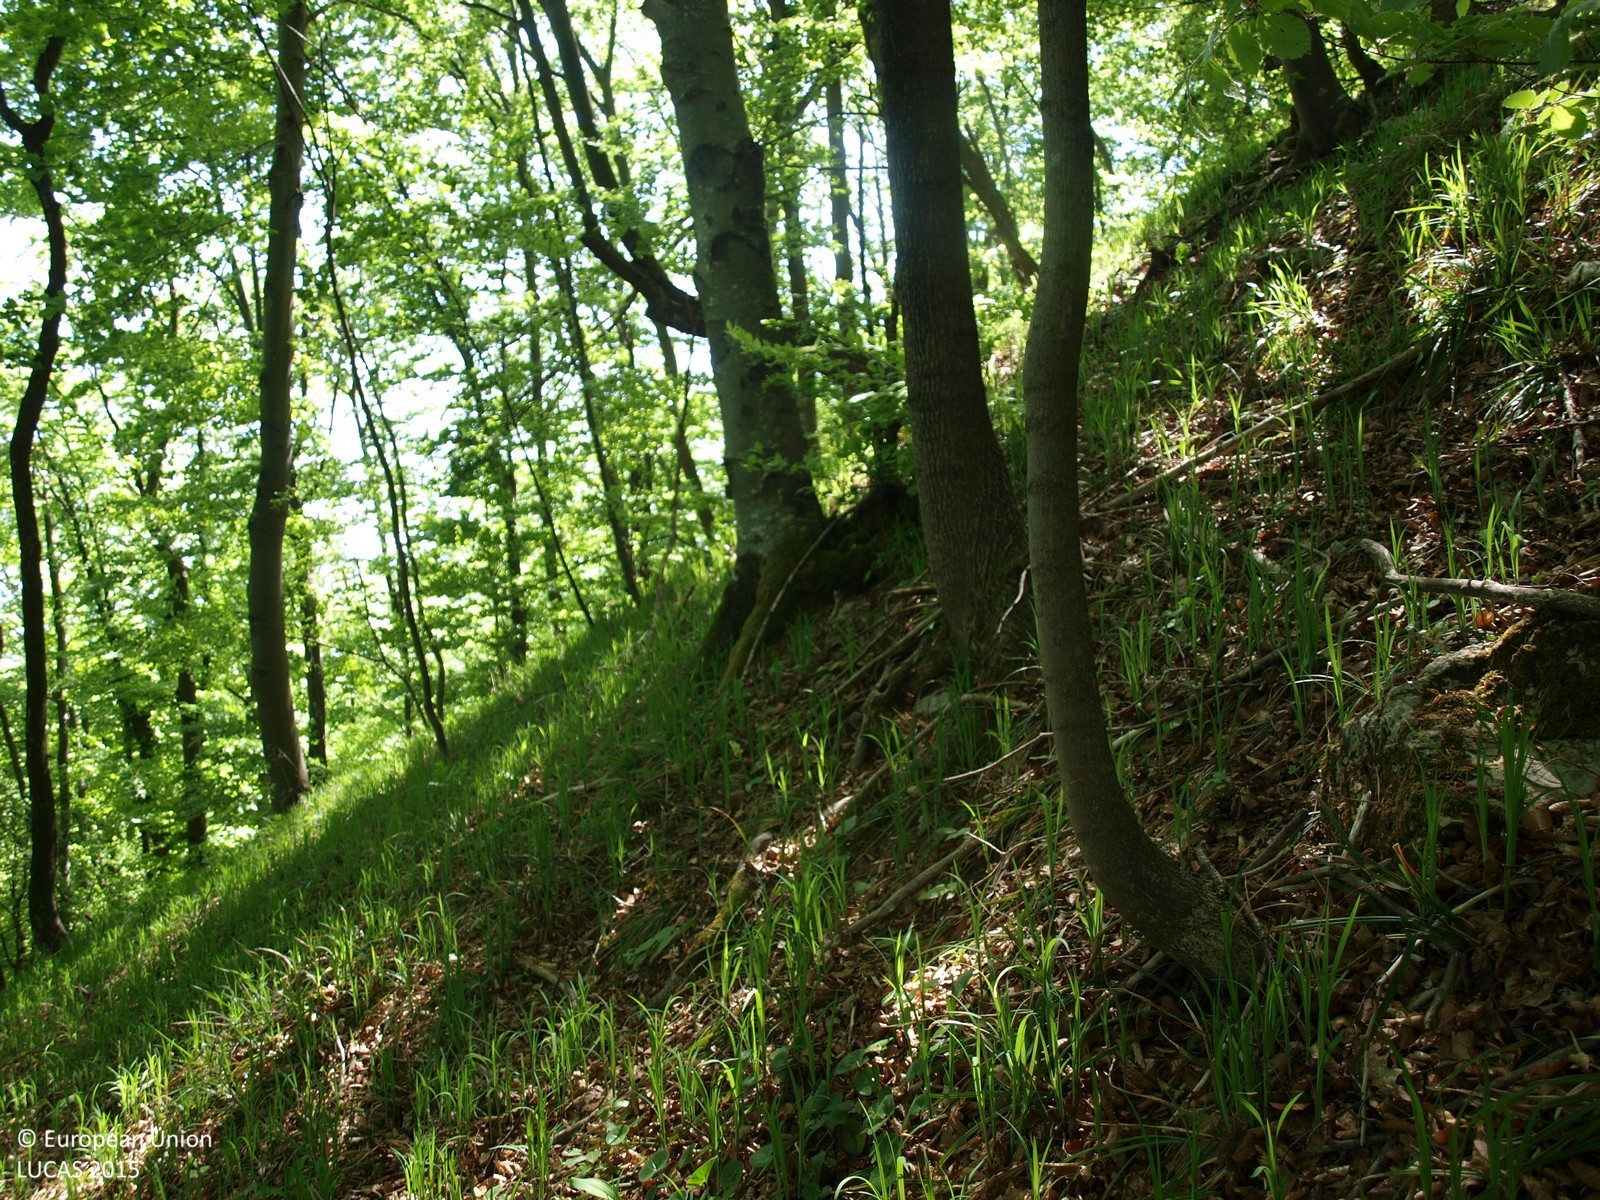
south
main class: Woodland
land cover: Broadleaved woodland
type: beech forest
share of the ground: > 75 %
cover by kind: broadleaved forest trees 100 %
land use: Forestry
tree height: > 5 m
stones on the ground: < 10 %
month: April
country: HR
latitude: 46.2712
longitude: 16.0331
